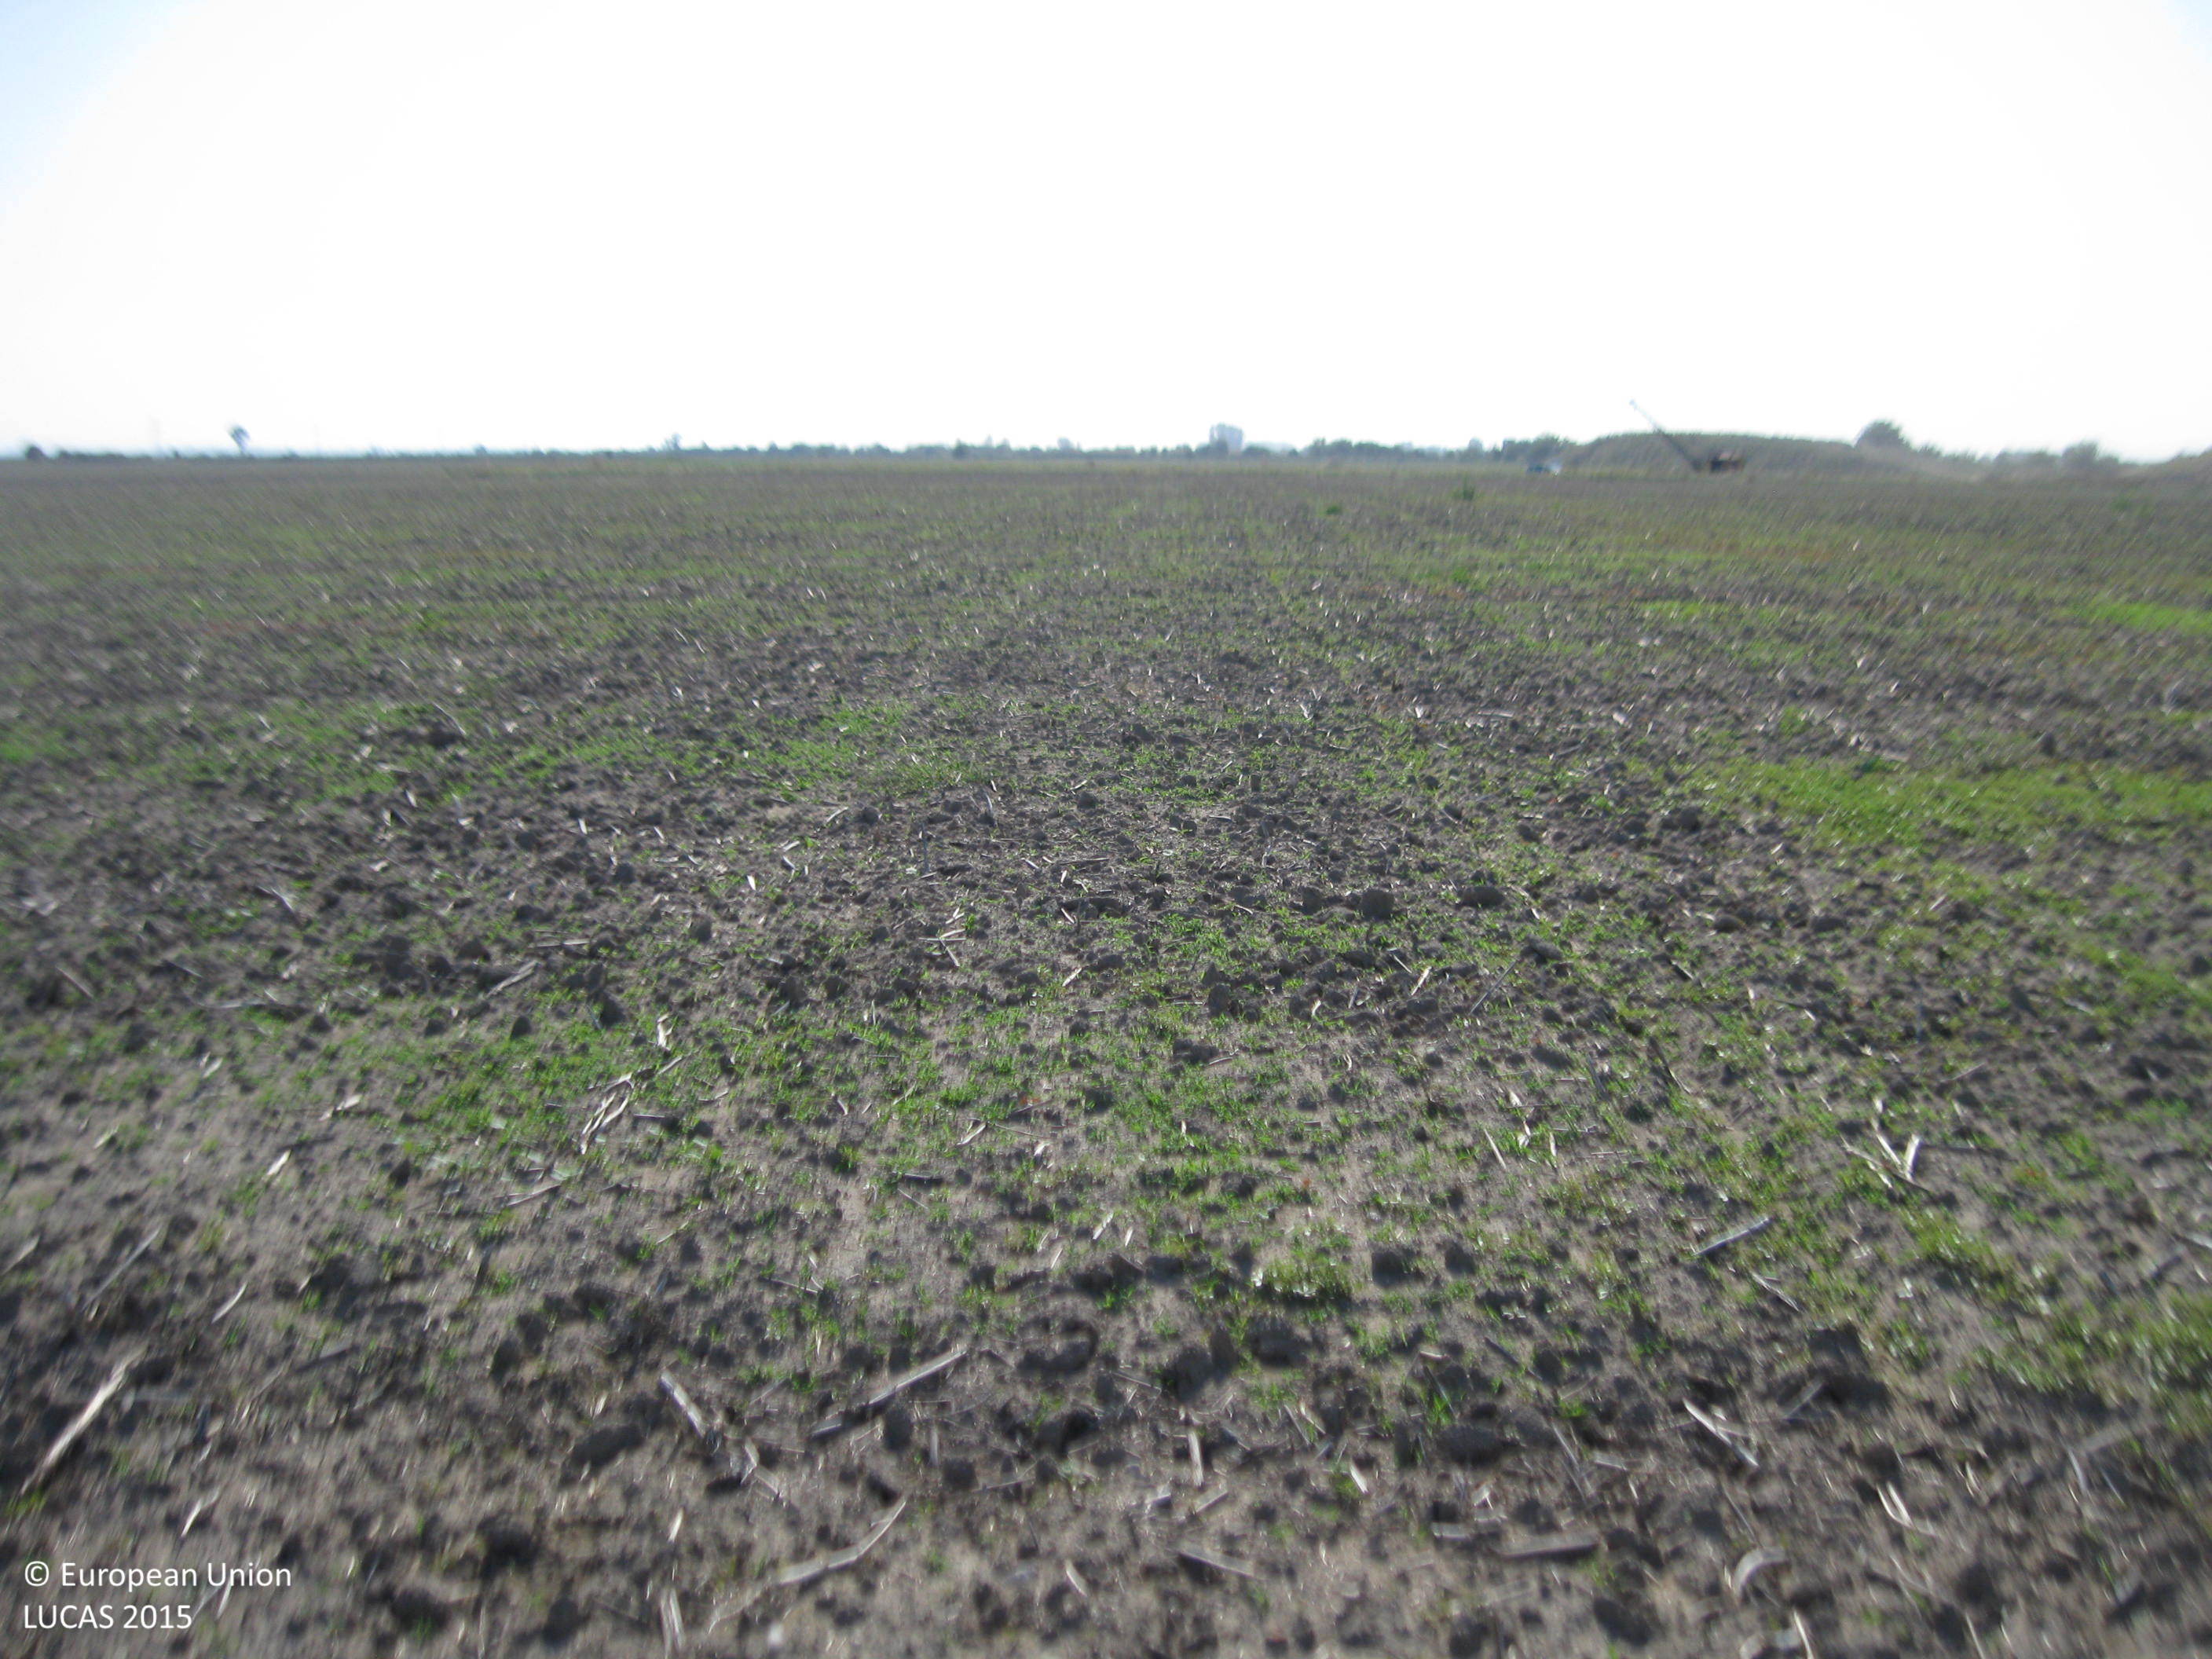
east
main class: Cropland
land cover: Sunflower
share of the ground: < 10 %
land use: Agriculture (excluding fallow land and kitchen gardens)
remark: Harvested field
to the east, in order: Sunflower
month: September
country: BG
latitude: 42.2874
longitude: 24.8382
